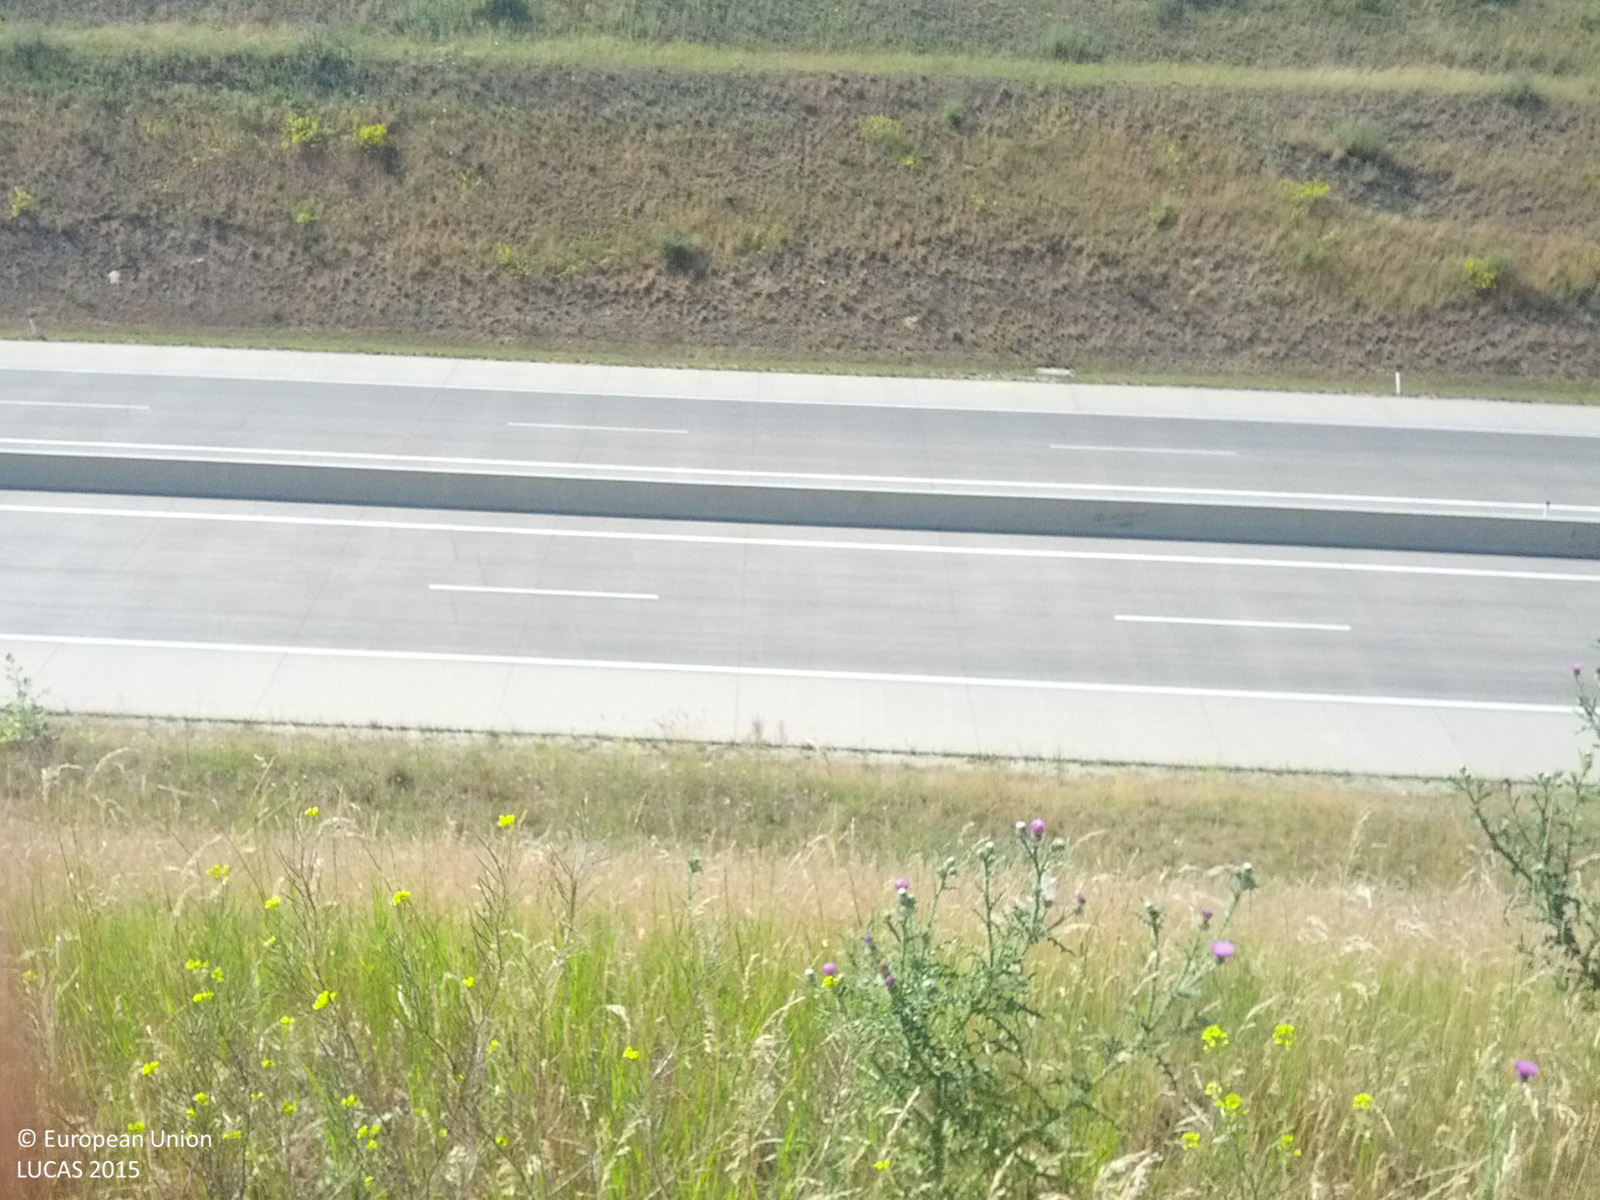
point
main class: Grassland
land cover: Grassland without tree/shrub cover
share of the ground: > 75 %
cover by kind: herbaceous plants 100 %
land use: Road transport
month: July
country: AT
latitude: 48.4790
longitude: 16.5674
